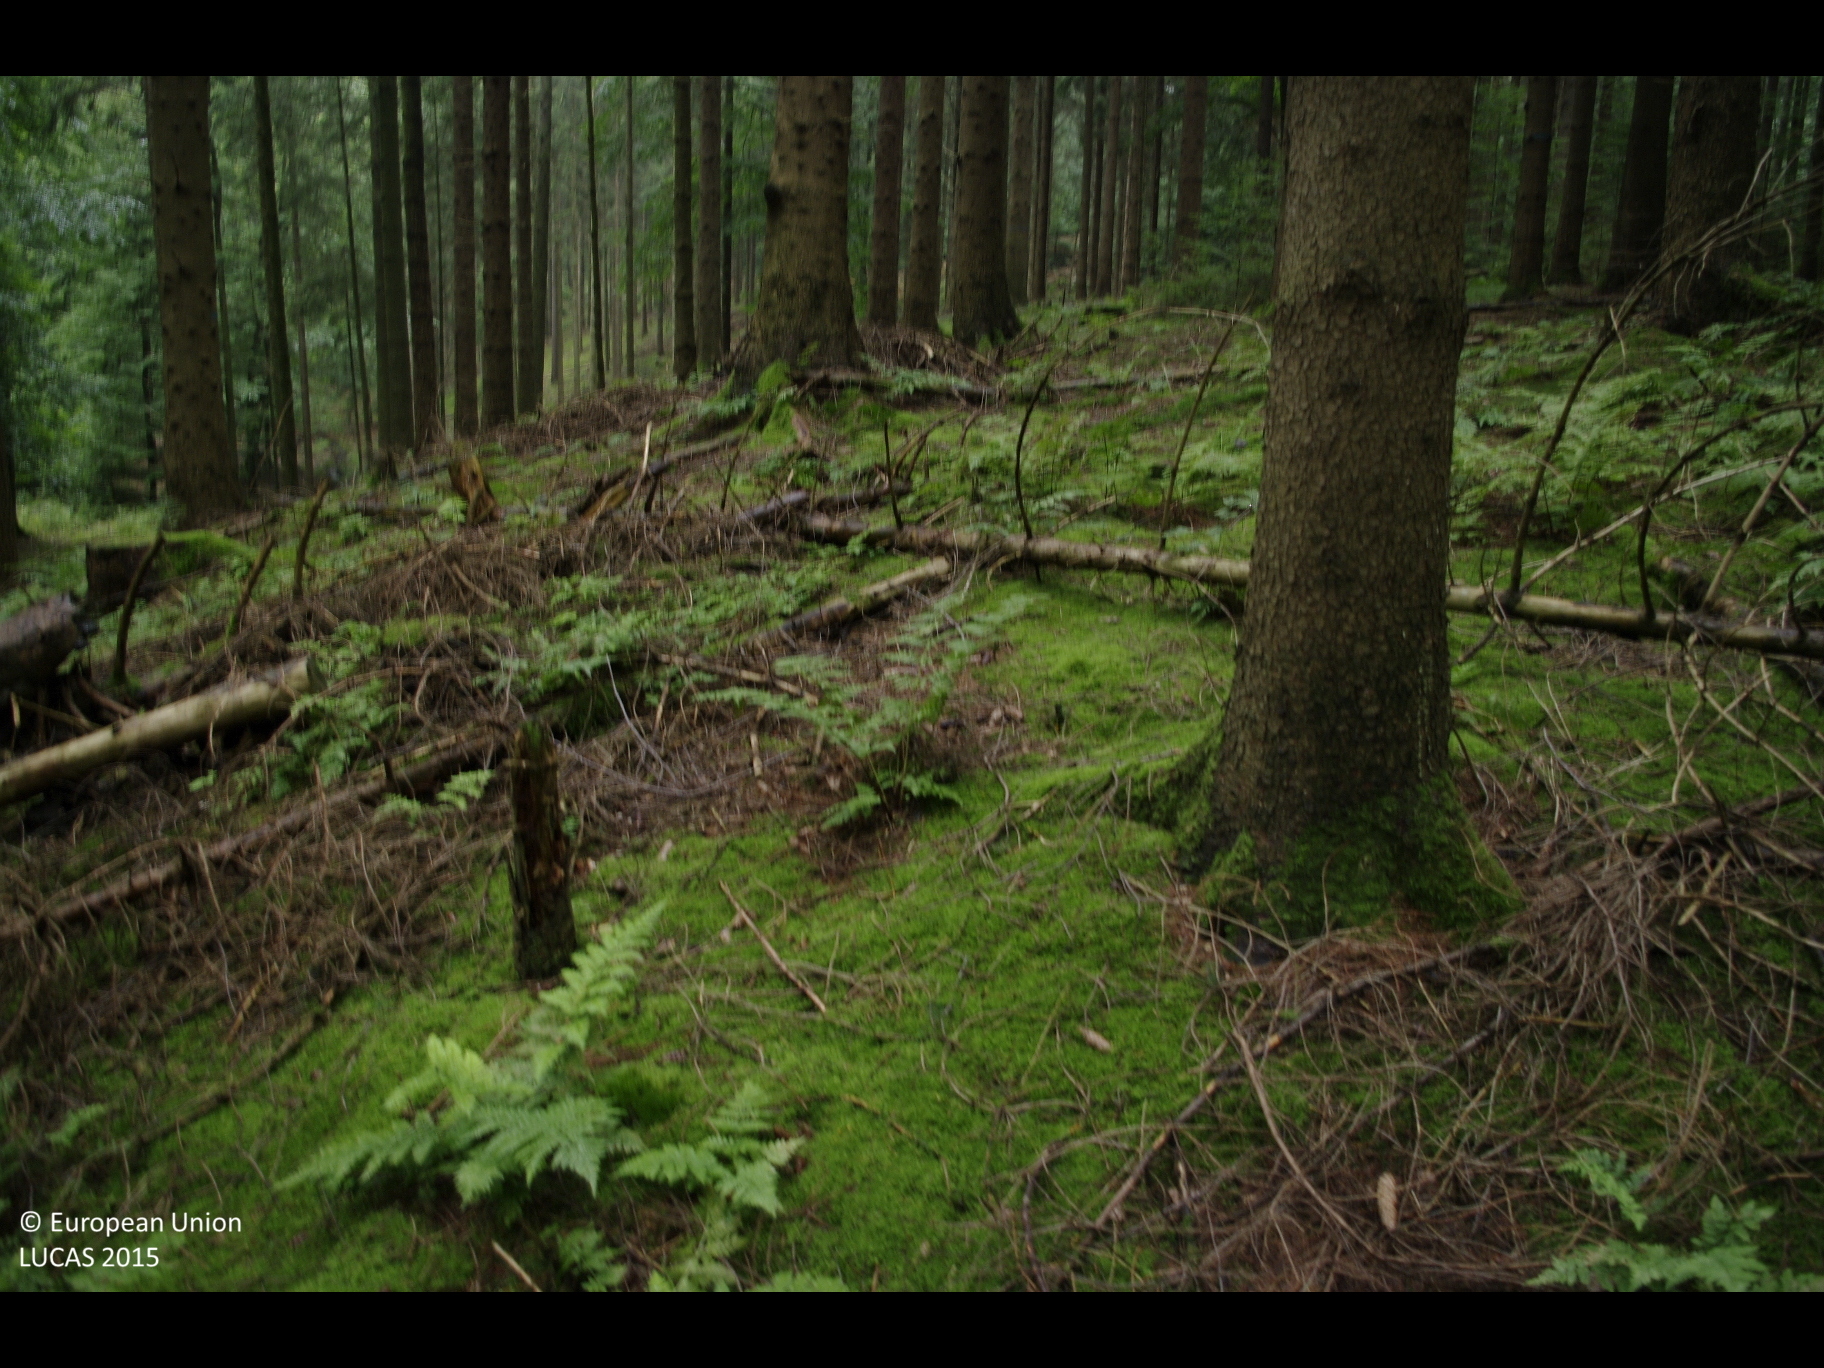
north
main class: Woodland
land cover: Other coniferous woodland
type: hemiboreal forest and nemoral coniferous forest and mixed broadleaved-coniferous forest
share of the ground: 50 - 75 %
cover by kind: coniferous forest trees 70 %, lichens and mosses 20 %, herbaceous plants 10 %
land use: Forestry
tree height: > 5 m
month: September
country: DE
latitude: 53.4198
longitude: 9.8646
